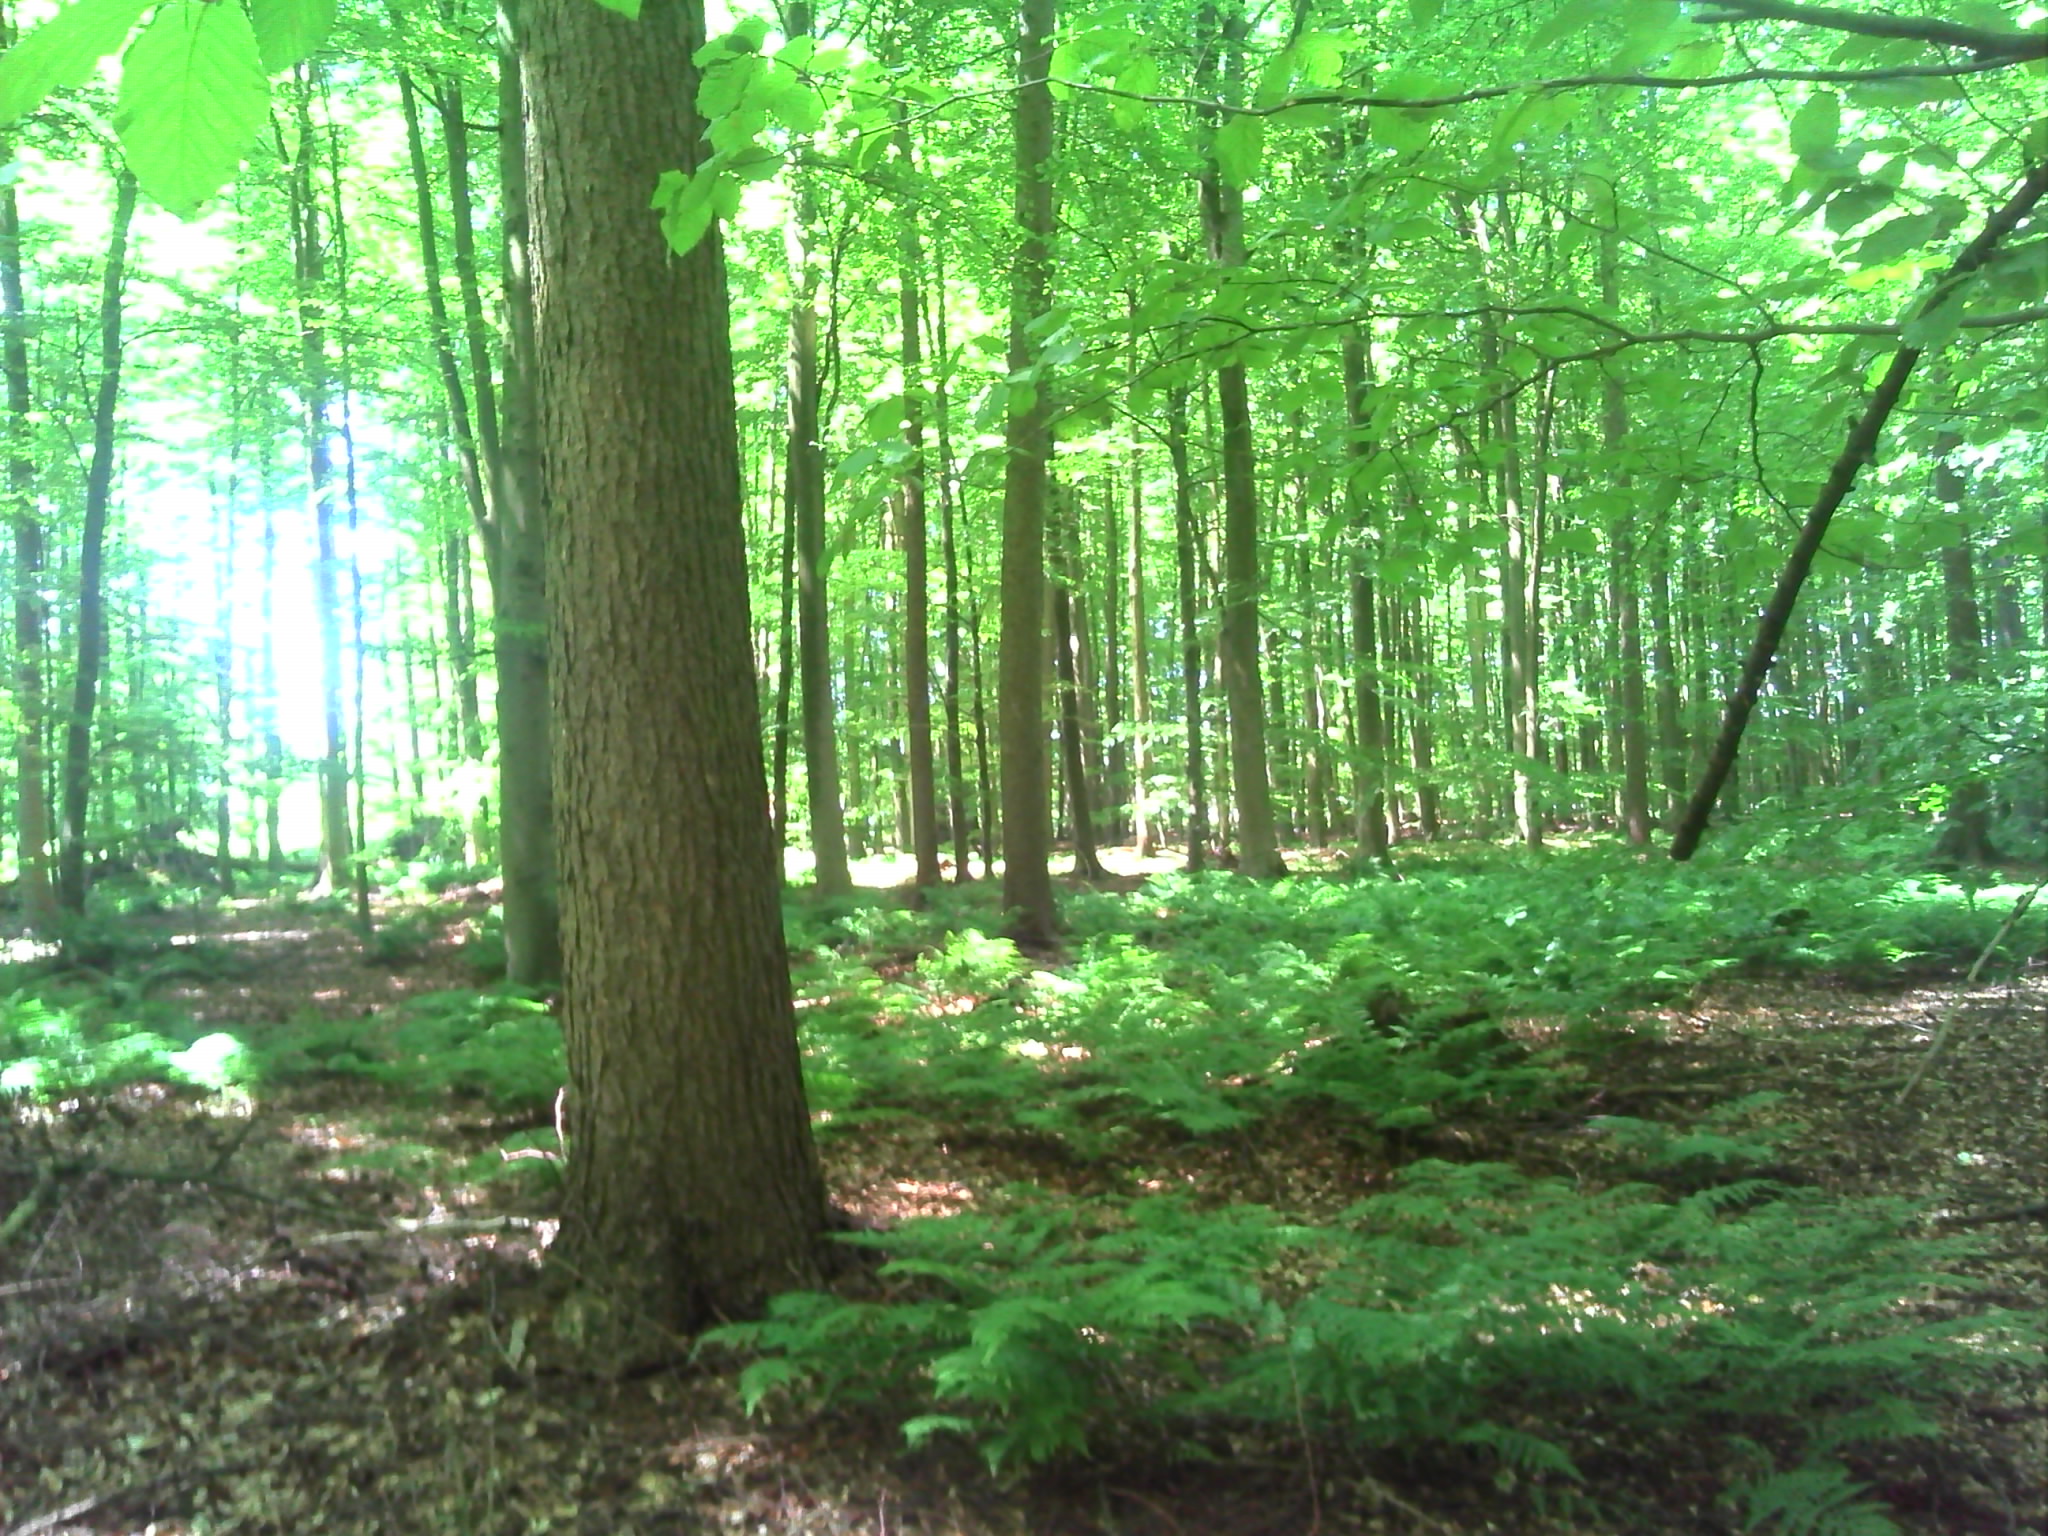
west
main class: Woodland
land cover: Broadleaved woodland
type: beech forest
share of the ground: > 75 %
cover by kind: broadleaved forest trees 80 %, shrubs 10 %, coniferous forest trees 5 %, herbaceous plants 5 %
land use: Forestry
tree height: > 5 m
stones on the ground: < 10 %
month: June
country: BE
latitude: 50.7495
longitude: 4.3970
